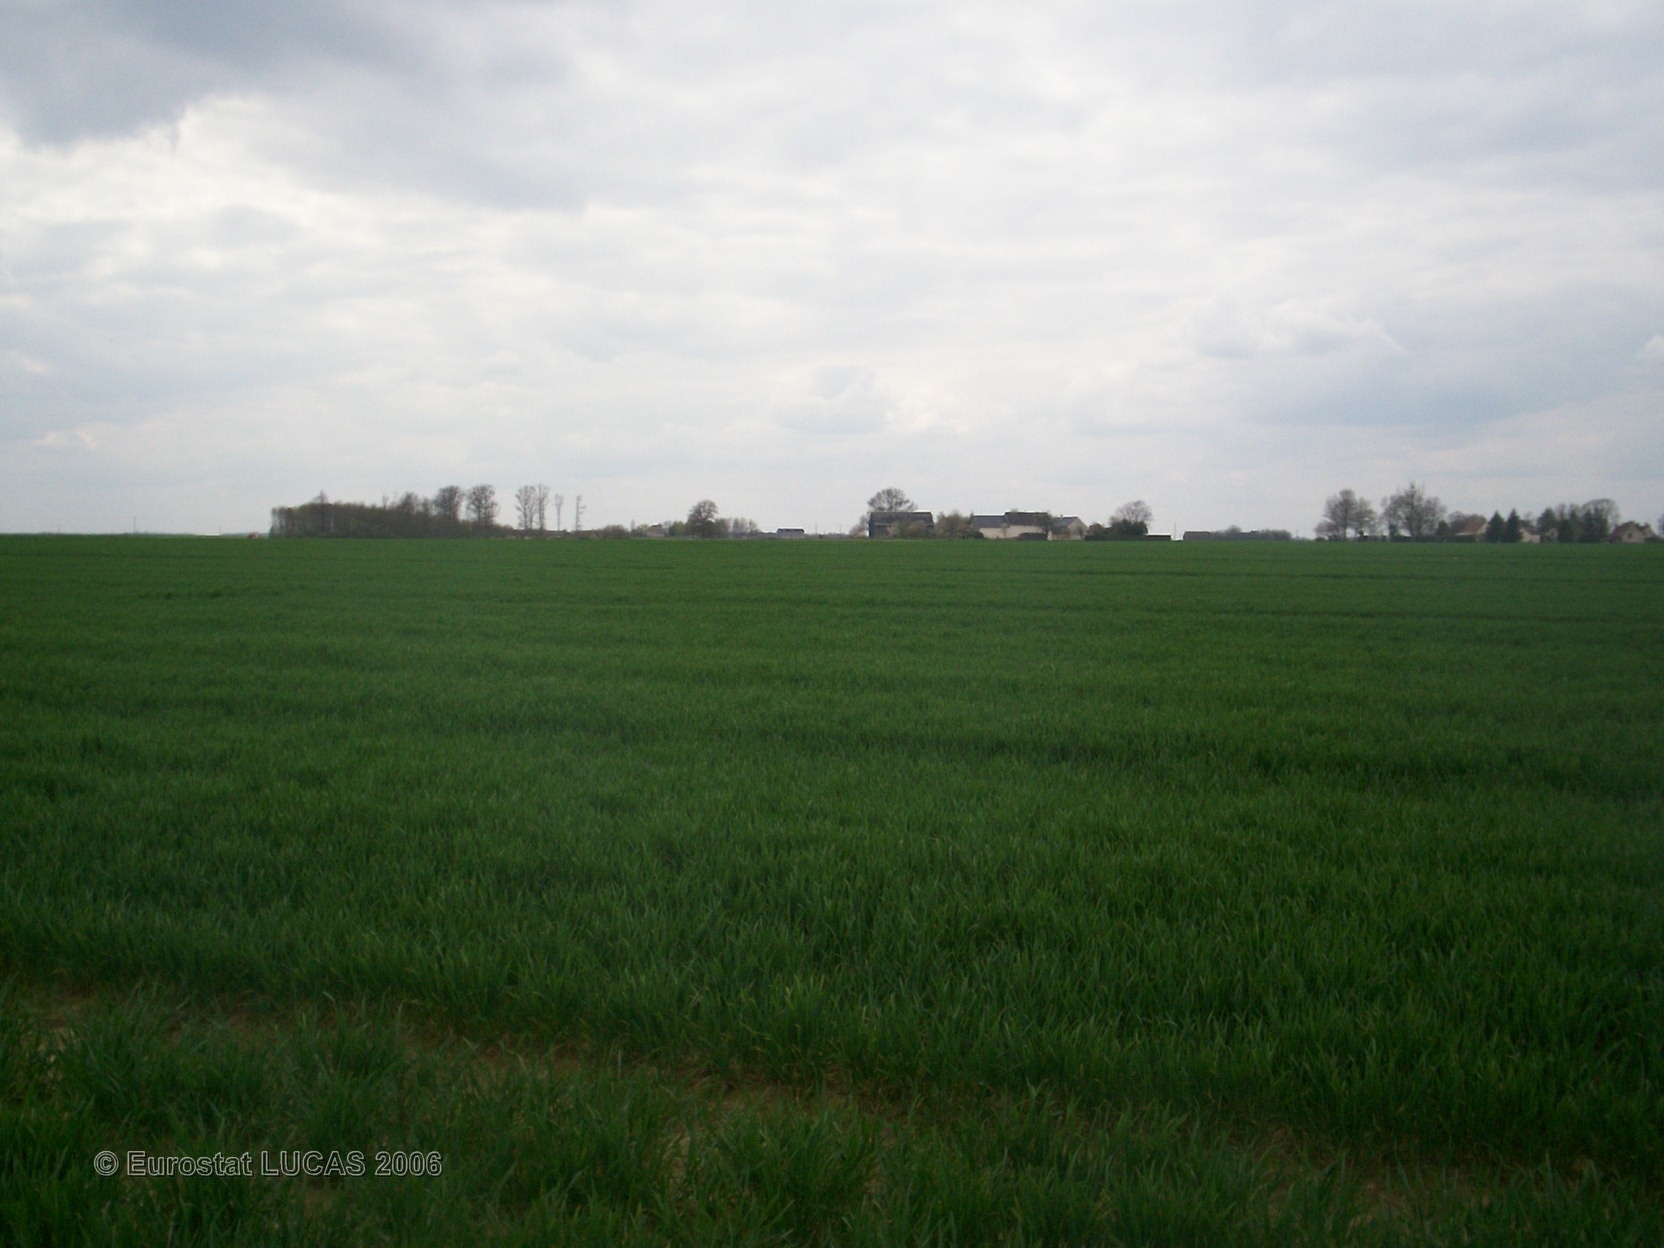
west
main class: Cropland
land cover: Common wheat
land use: Agriculture (excluding fallow land and kitchen gardens)
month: April
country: FR
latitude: 47.6776
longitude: 0.8297
